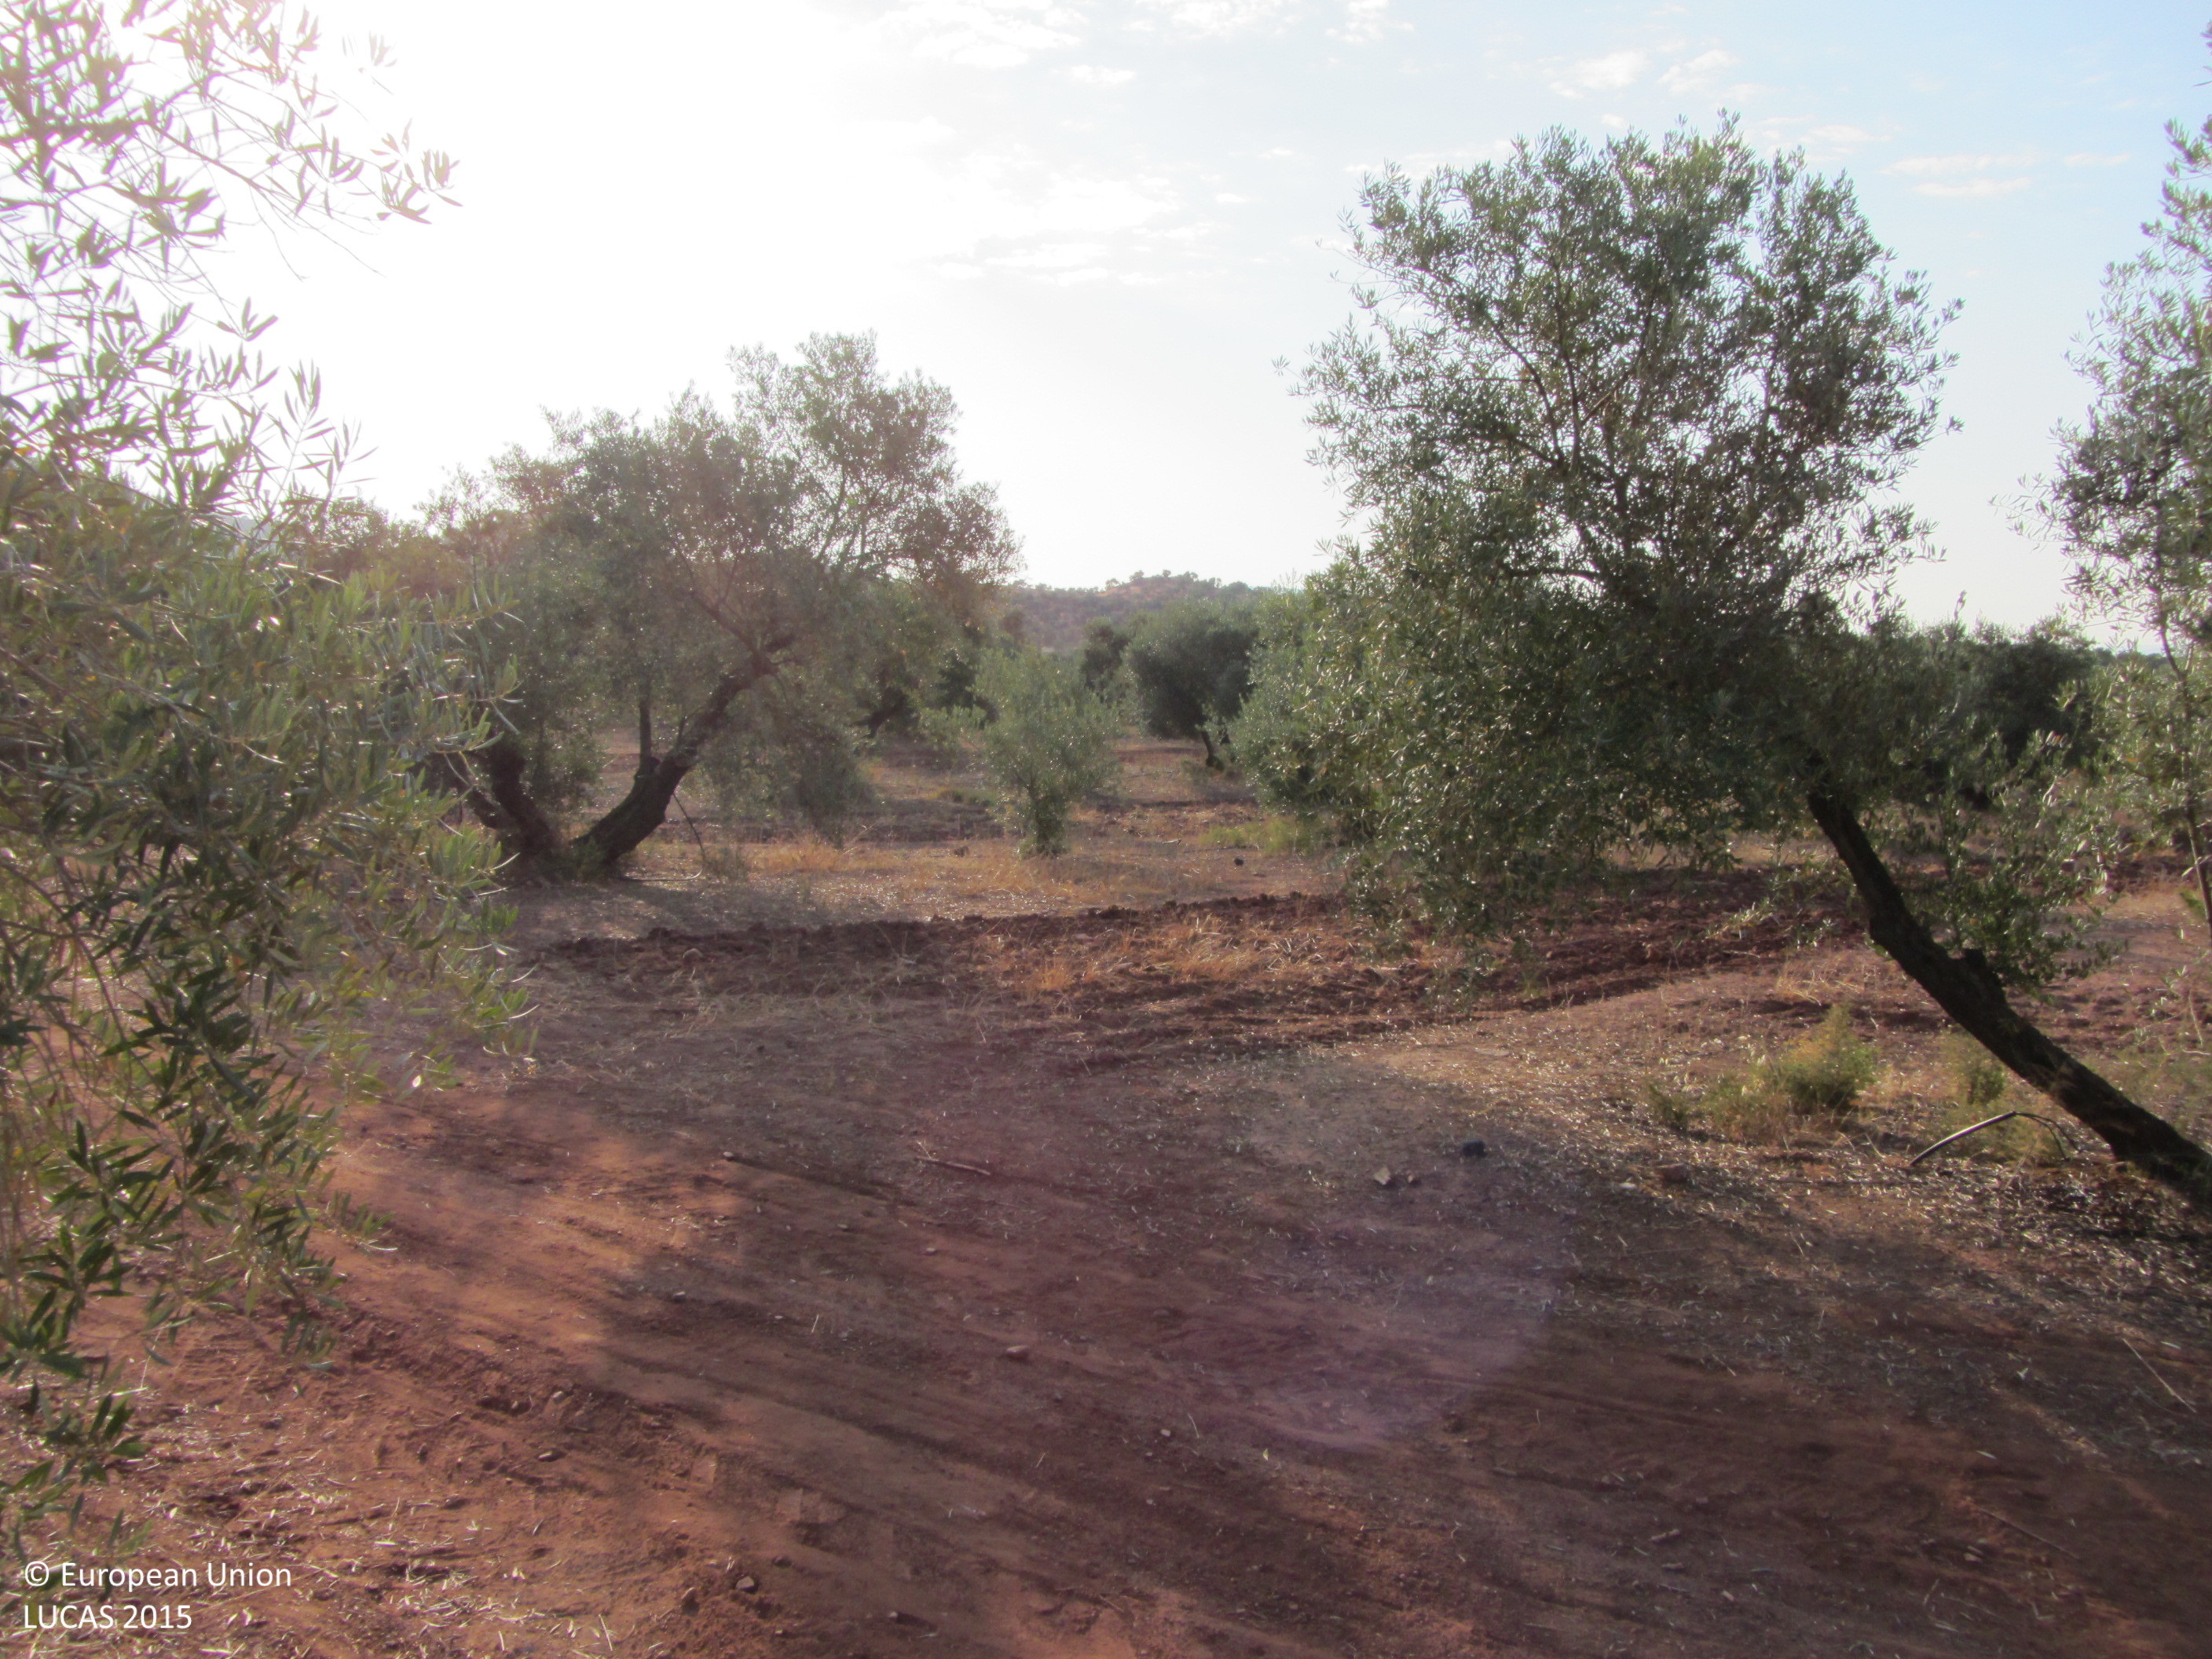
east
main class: Grassland
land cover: Grassland without tree/shrub cover
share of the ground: > 75 %
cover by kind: herbaceous plants 100 %
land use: Agriculture (excluding fallow land and kitchen gardens)
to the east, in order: Tracks; Grass margins; Fences; Grass margins; Olive groves; Grass margins; Rivers and streams; Grass margins
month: June
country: ES
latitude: 38.1476
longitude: -3.4333
